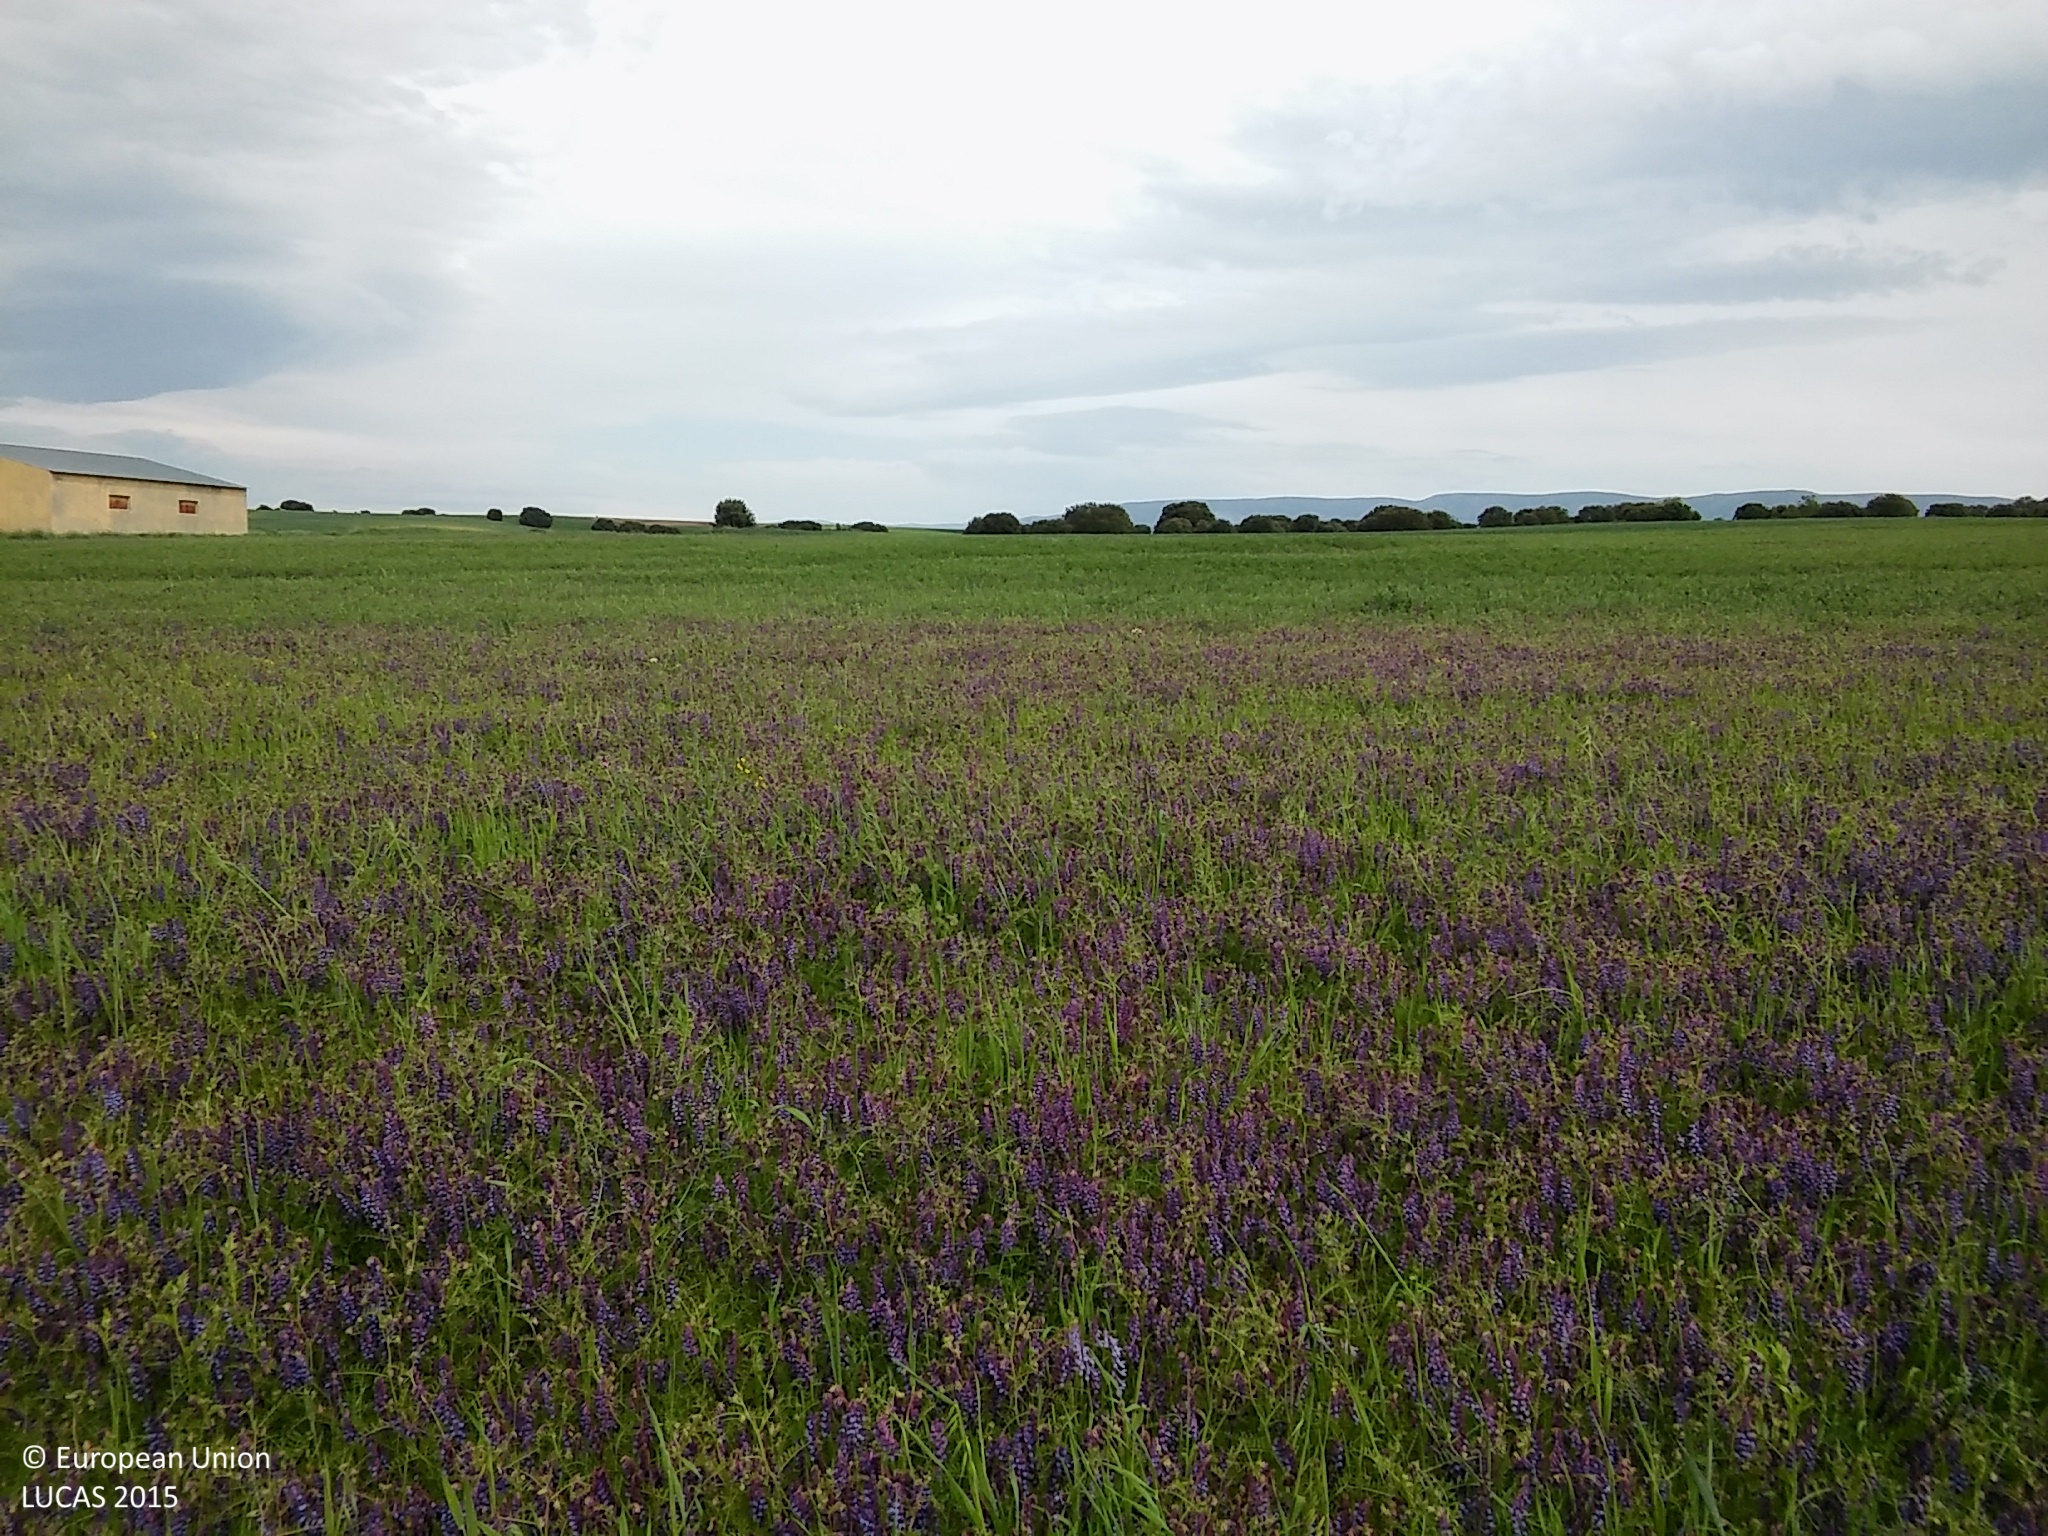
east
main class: Cropland
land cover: Dry pulses
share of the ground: > 75 %
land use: Agriculture (excluding fallow land and kitchen gardens)
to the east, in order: Dry pulses; Tracks; Common wheat; Grassland without tree/shrub cover; Grass margins
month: May
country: ES
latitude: 41.0606
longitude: -4.0805
